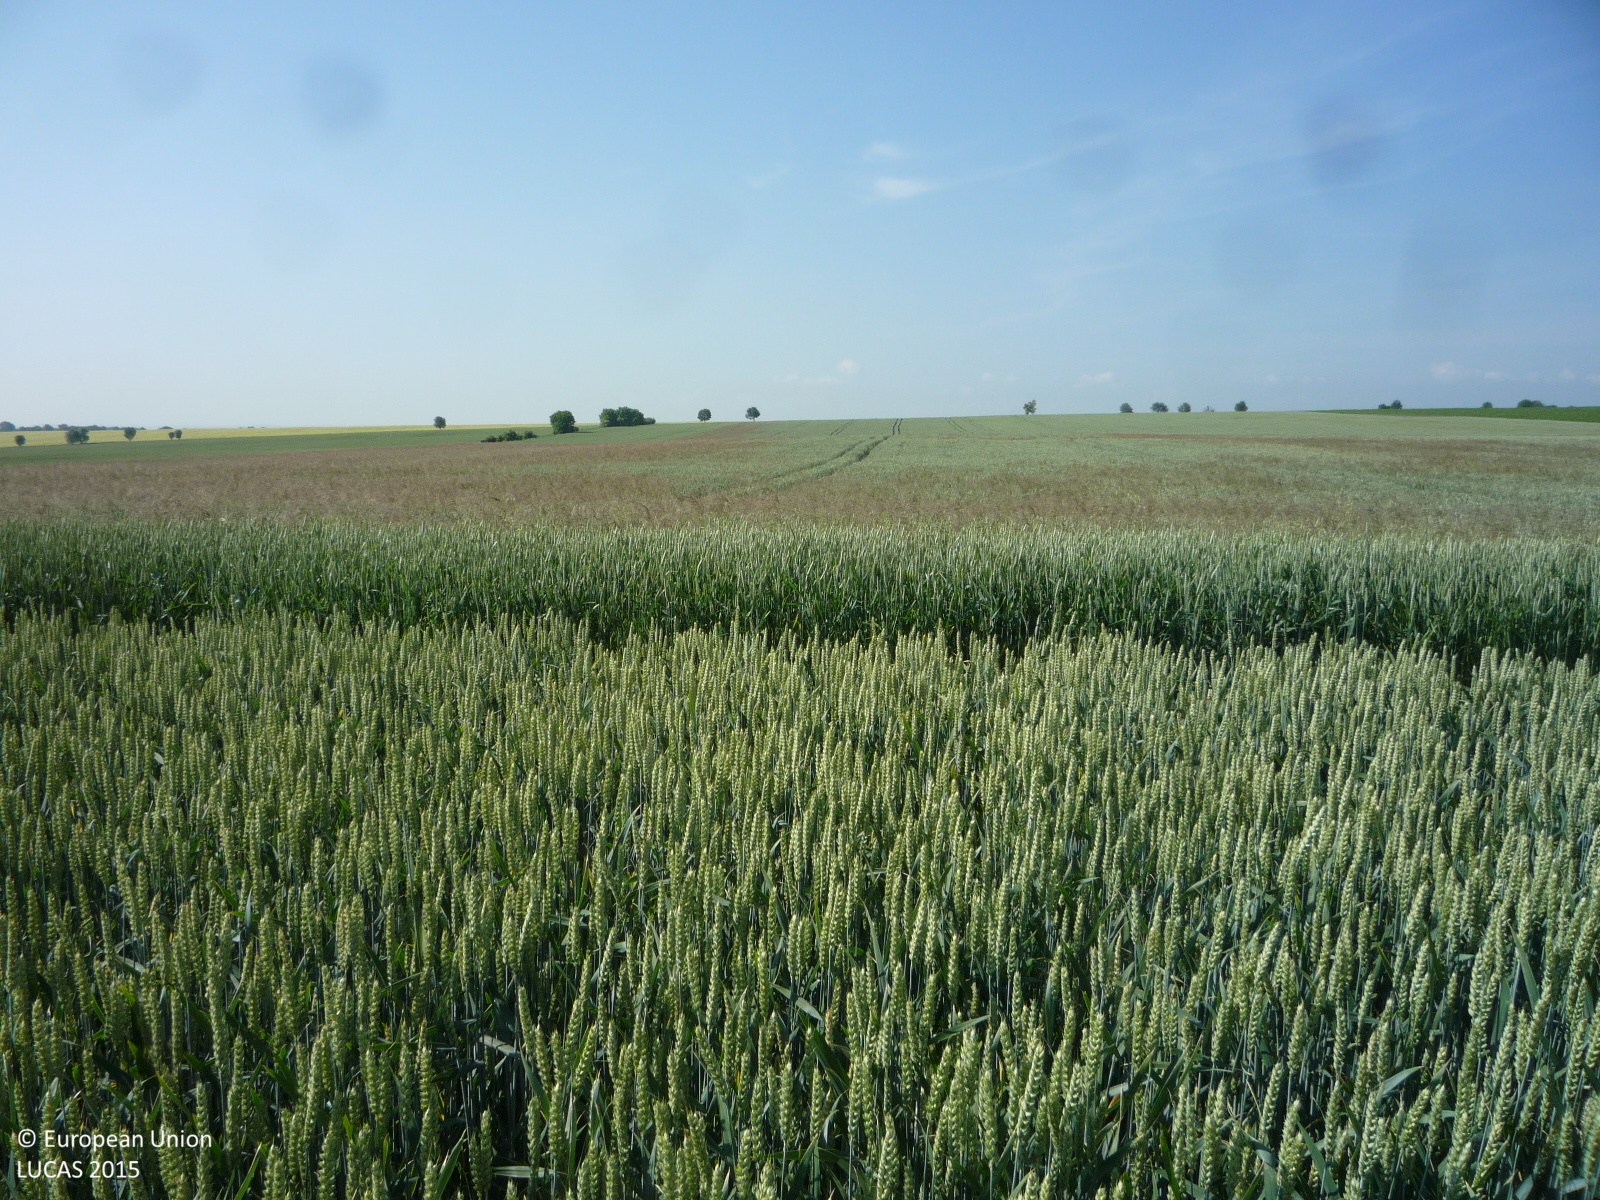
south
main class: Cropland
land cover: Common wheat
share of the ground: > 75 %
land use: Agriculture (excluding fallow land and kitchen gardens)
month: June
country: CZ
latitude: 50.3778
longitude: 14.1776
